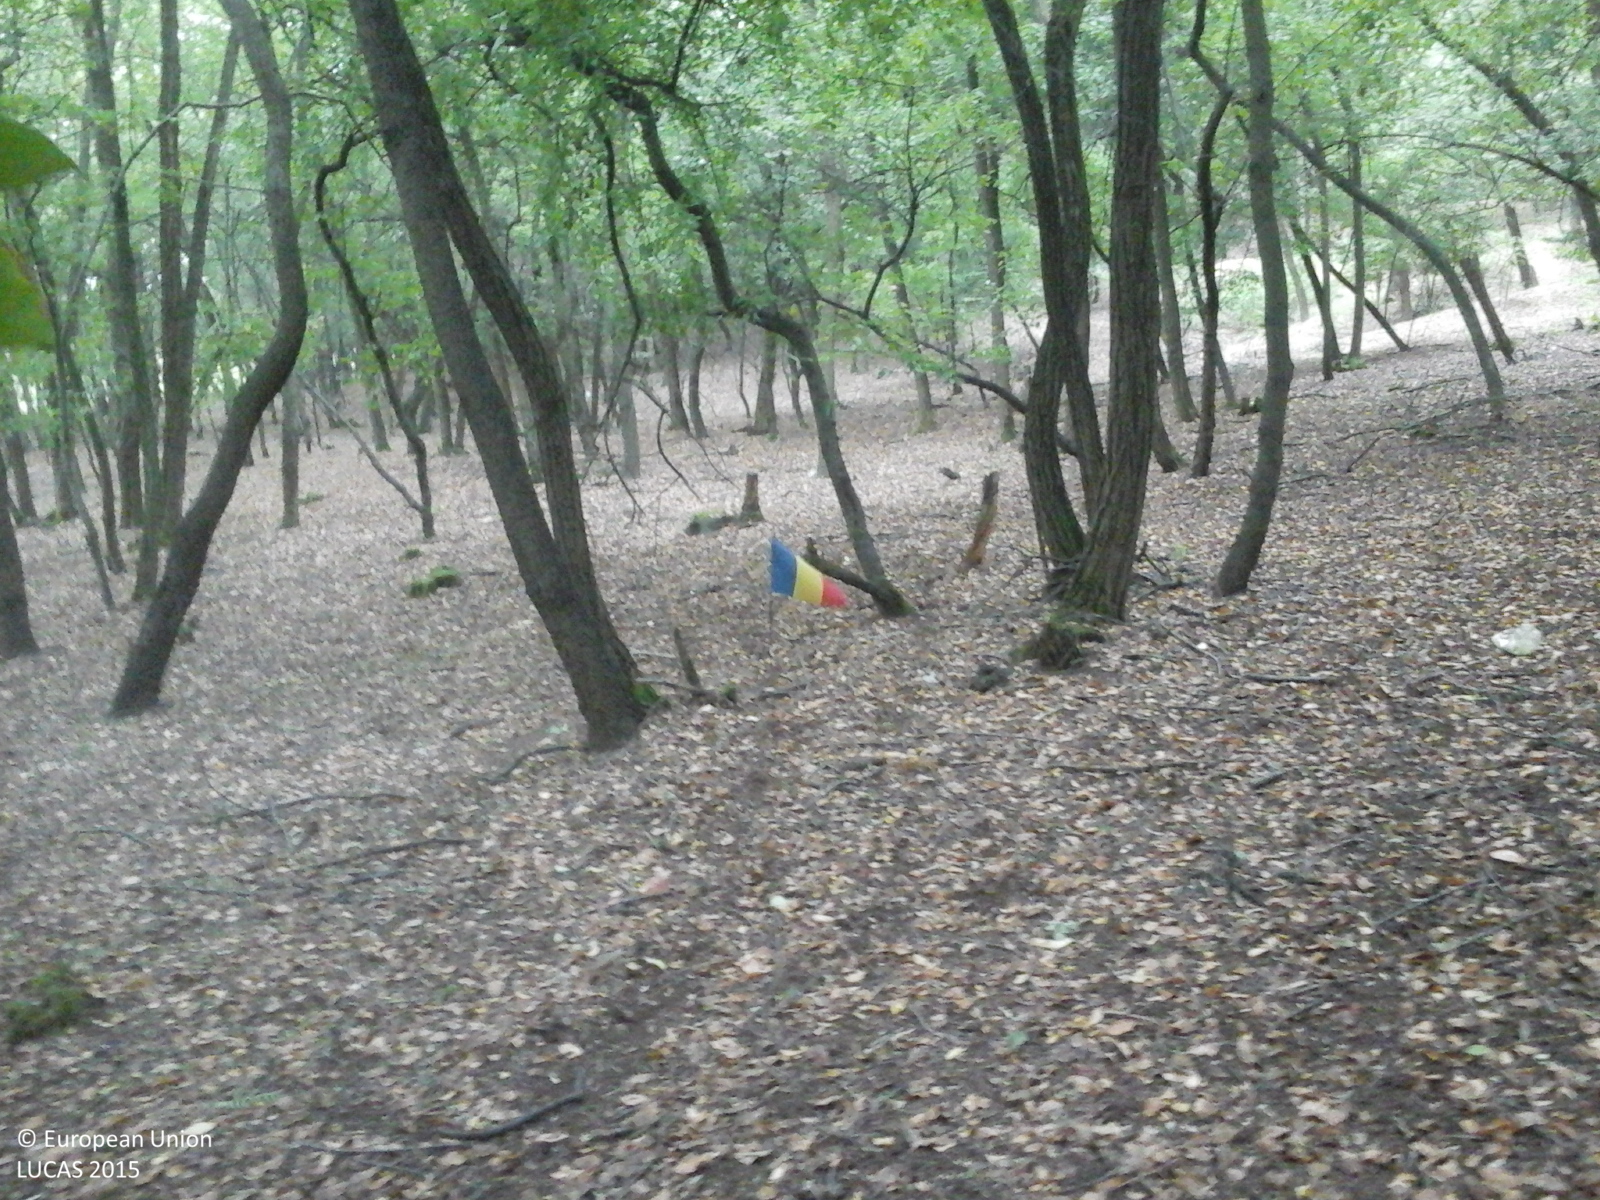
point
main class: Woodland
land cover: Broadleaved woodland
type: exotic forest
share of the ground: > 75 %
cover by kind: broadleaved forest trees 100 %
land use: Forestry
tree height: > 5 m
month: September
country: RO
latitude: 47.5035
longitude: 22.0654
